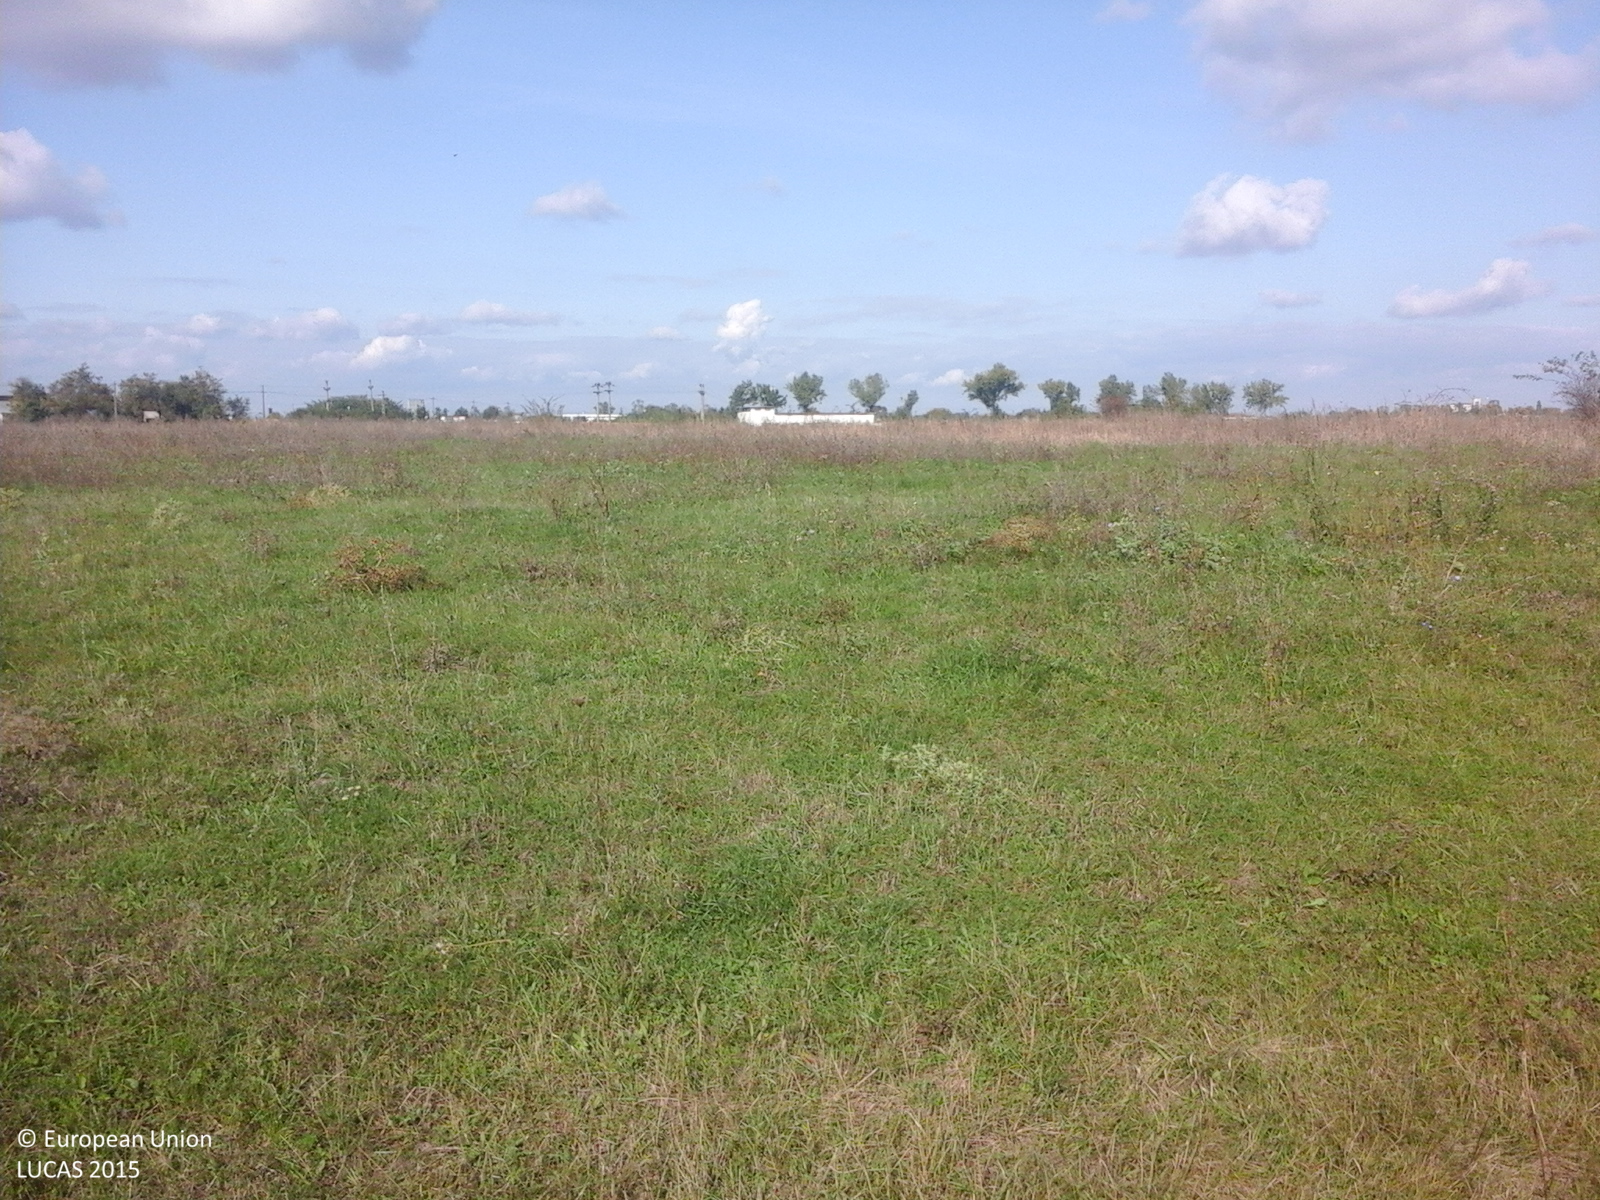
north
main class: Grassland
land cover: Spontaneously vegetated surfaces
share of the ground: > 75 %
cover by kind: herbaceous plants 100 %
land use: Agriculture (excluding fallow land and kitchen gardens)
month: October
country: RO
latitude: 44.6623
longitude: 25.9831
